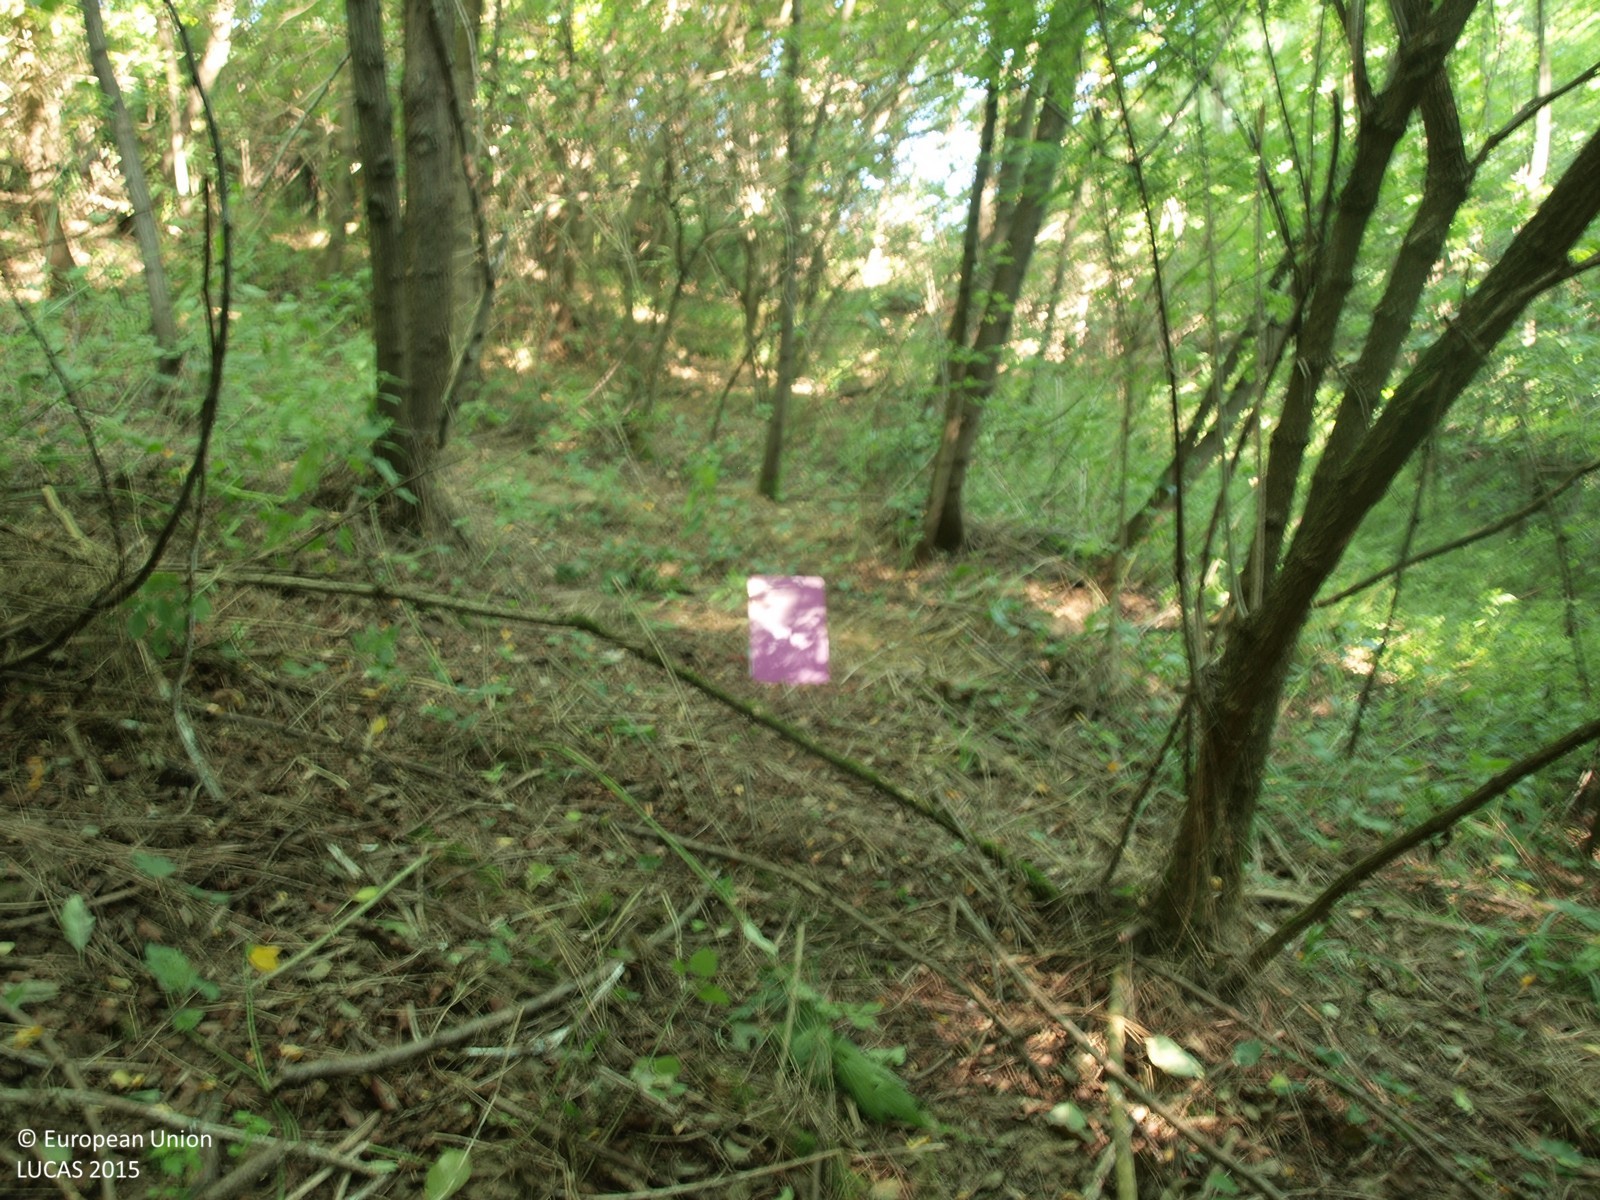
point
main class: Woodland
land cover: Broadleaved woodland
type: mesophytic deciduous forest
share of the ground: > 75 %
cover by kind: broadleaved forest trees 100 %
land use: Forestry
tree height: > 5 m
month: August
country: HR
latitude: 45.9795
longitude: 16.3886
